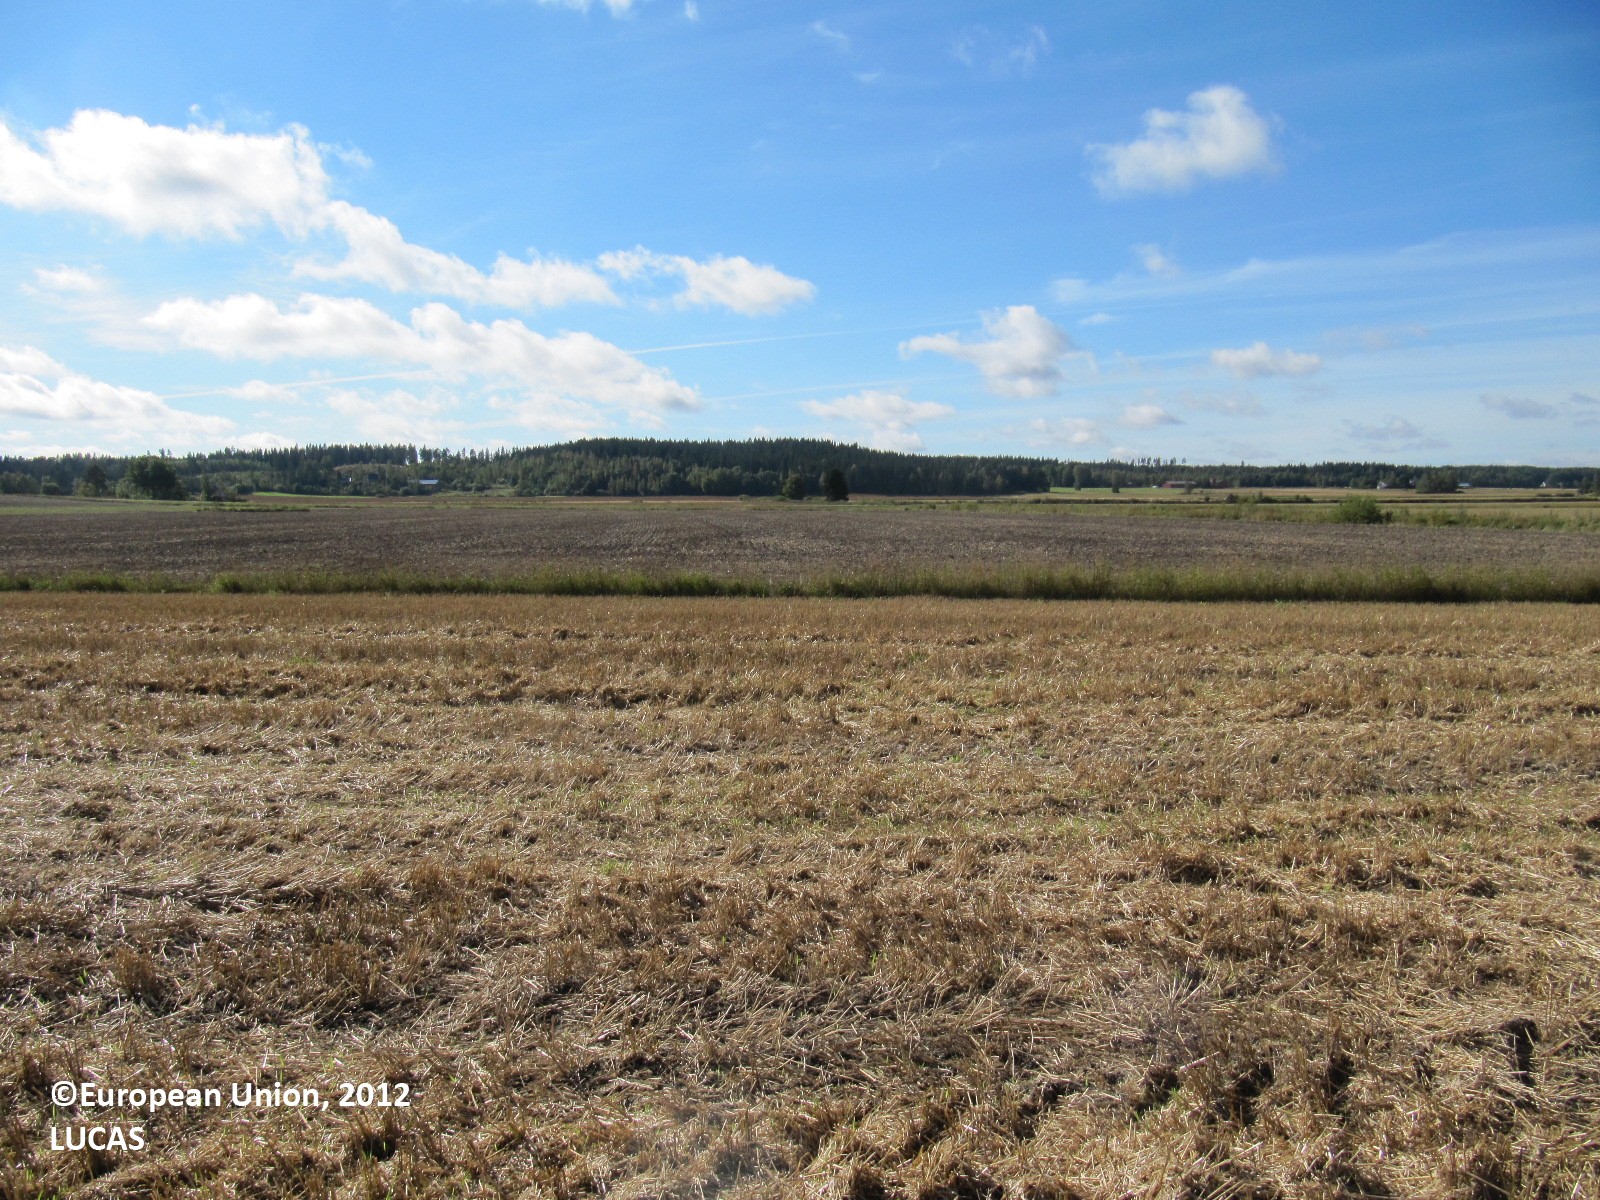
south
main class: Cropland
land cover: Barley
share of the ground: 50 - 75 %
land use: Agriculture (excluding fallow land and kitchen gardens)
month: September
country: FI
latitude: 60.7925
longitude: 23.2898
